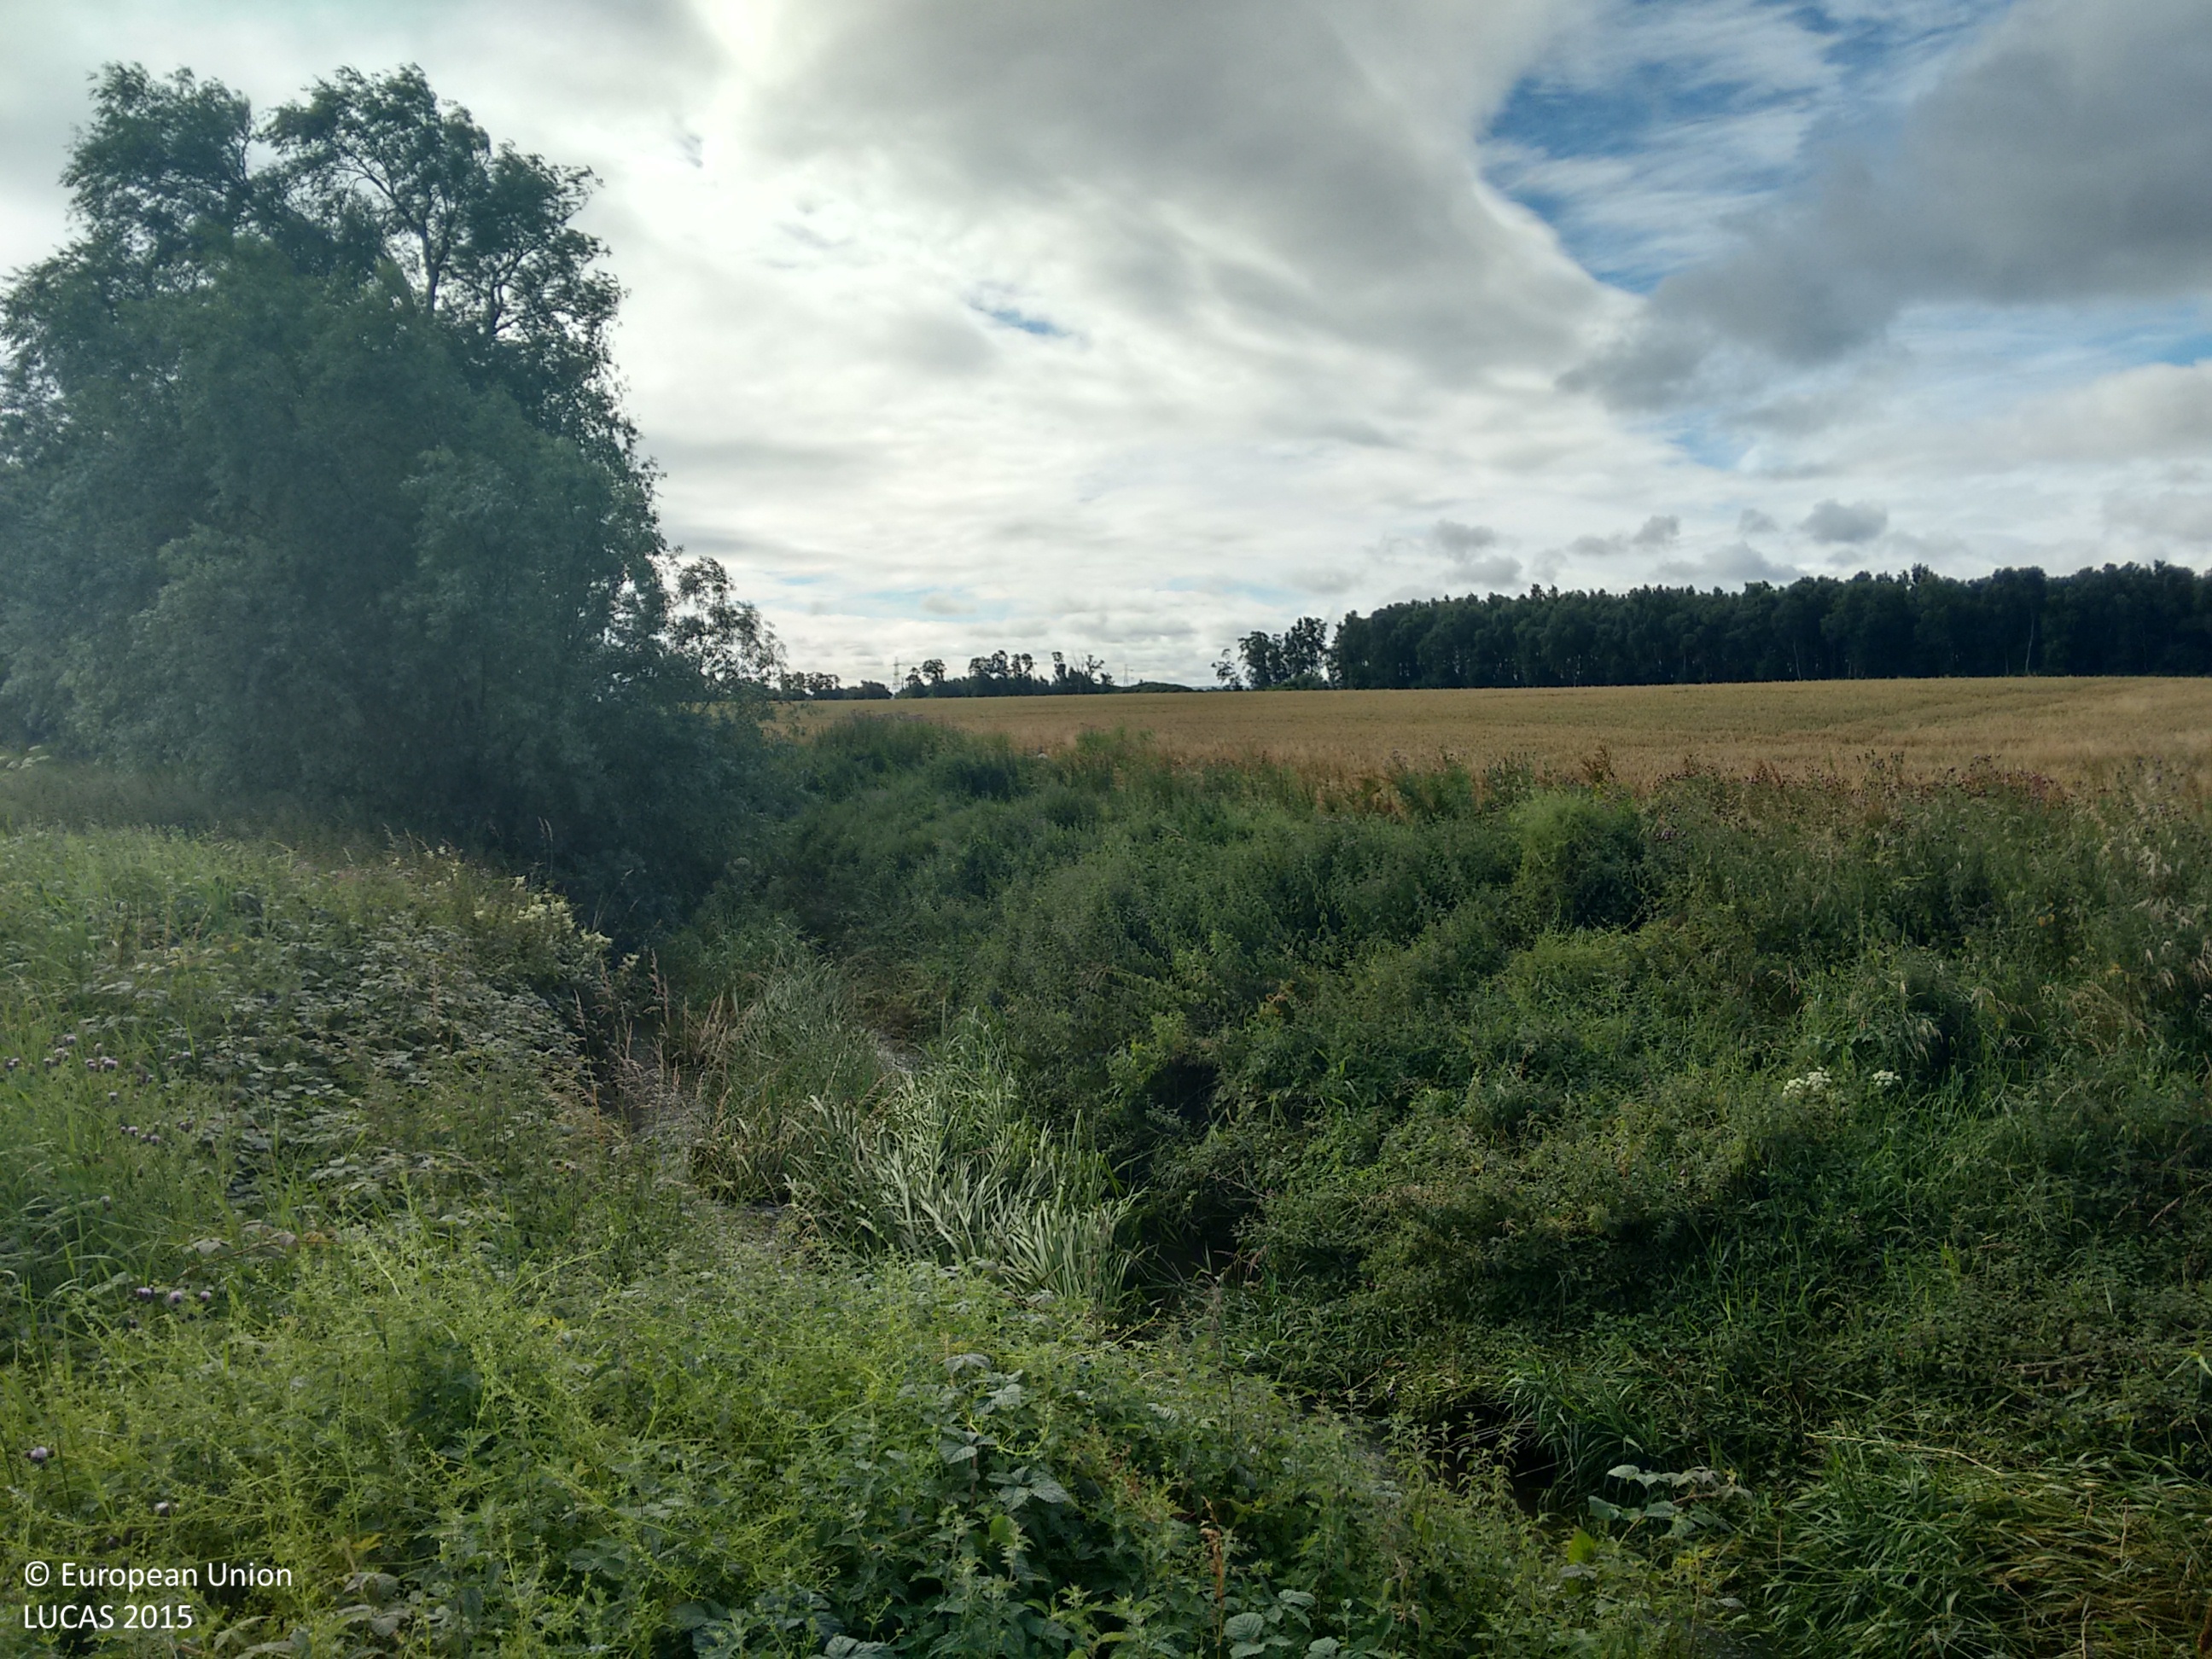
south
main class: Cropland
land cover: Barley
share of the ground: > 75 %
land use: Agriculture (excluding fallow land and kitchen gardens)
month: August
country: GB
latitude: 56.0605
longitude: -3.7816
